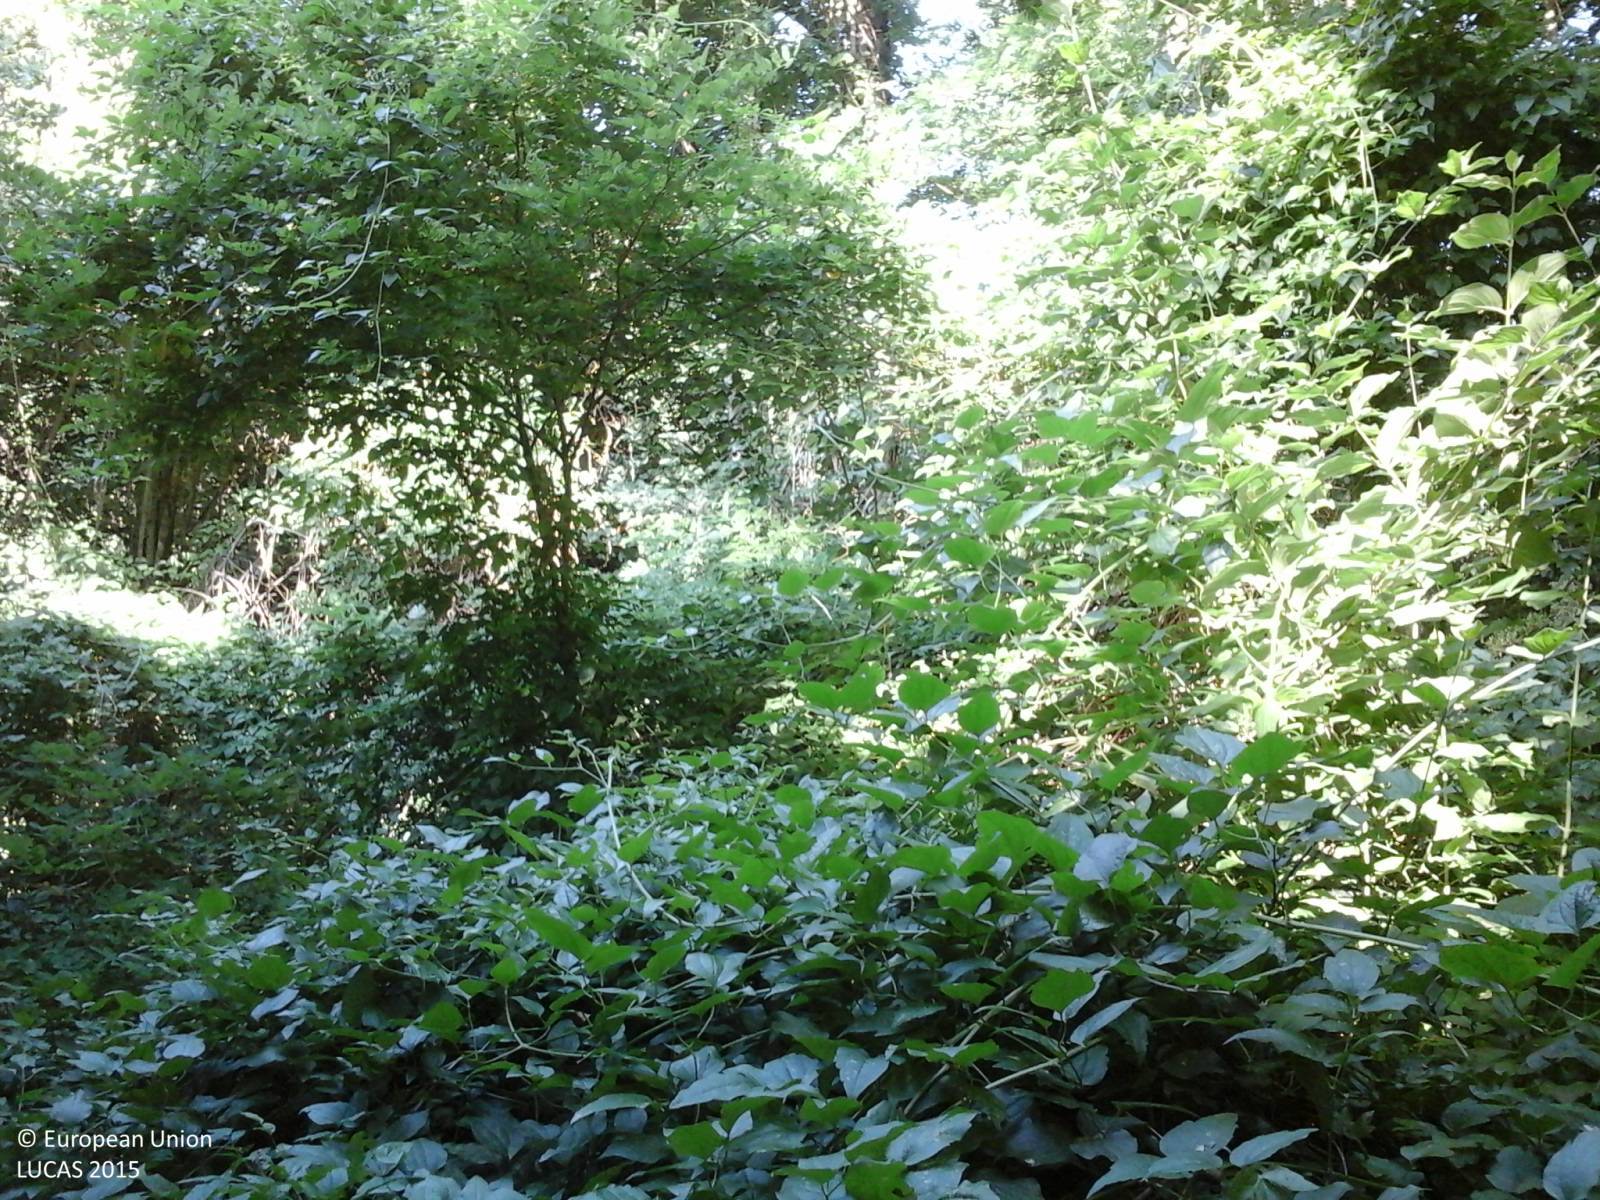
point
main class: Woodland
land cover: Broadleaved woodland
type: thermophilous deciduous forest
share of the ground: > 75 %
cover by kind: broadleaved forest trees 70 %, shrubs 30 %
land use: Semi-natural and natural areas not in use
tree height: > 5 m
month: July
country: IT
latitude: 42.4036
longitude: 13.2336
